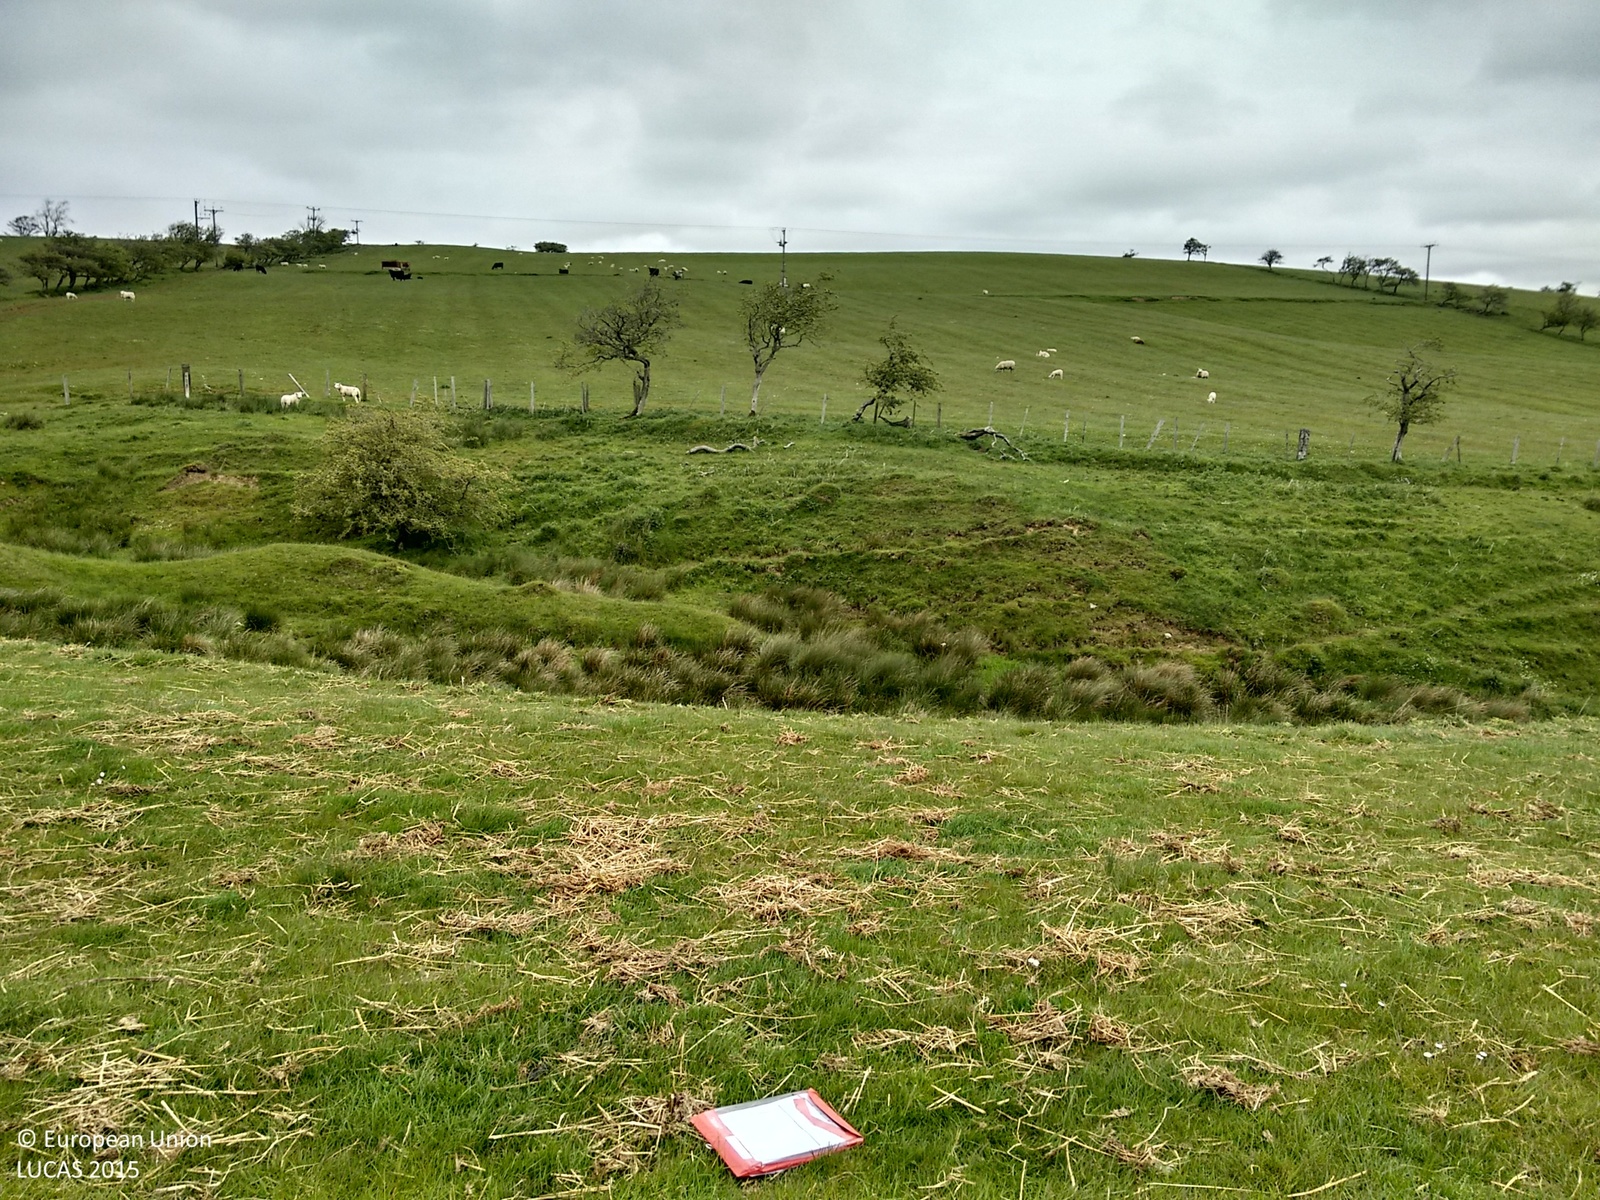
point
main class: Grassland
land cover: Grassland without tree/shrub cover
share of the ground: > 75 %
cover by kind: herbaceous plants 100 %
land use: Agriculture (excluding fallow land and kitchen gardens)
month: June
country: GB
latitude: 55.0871
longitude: -2.2630
